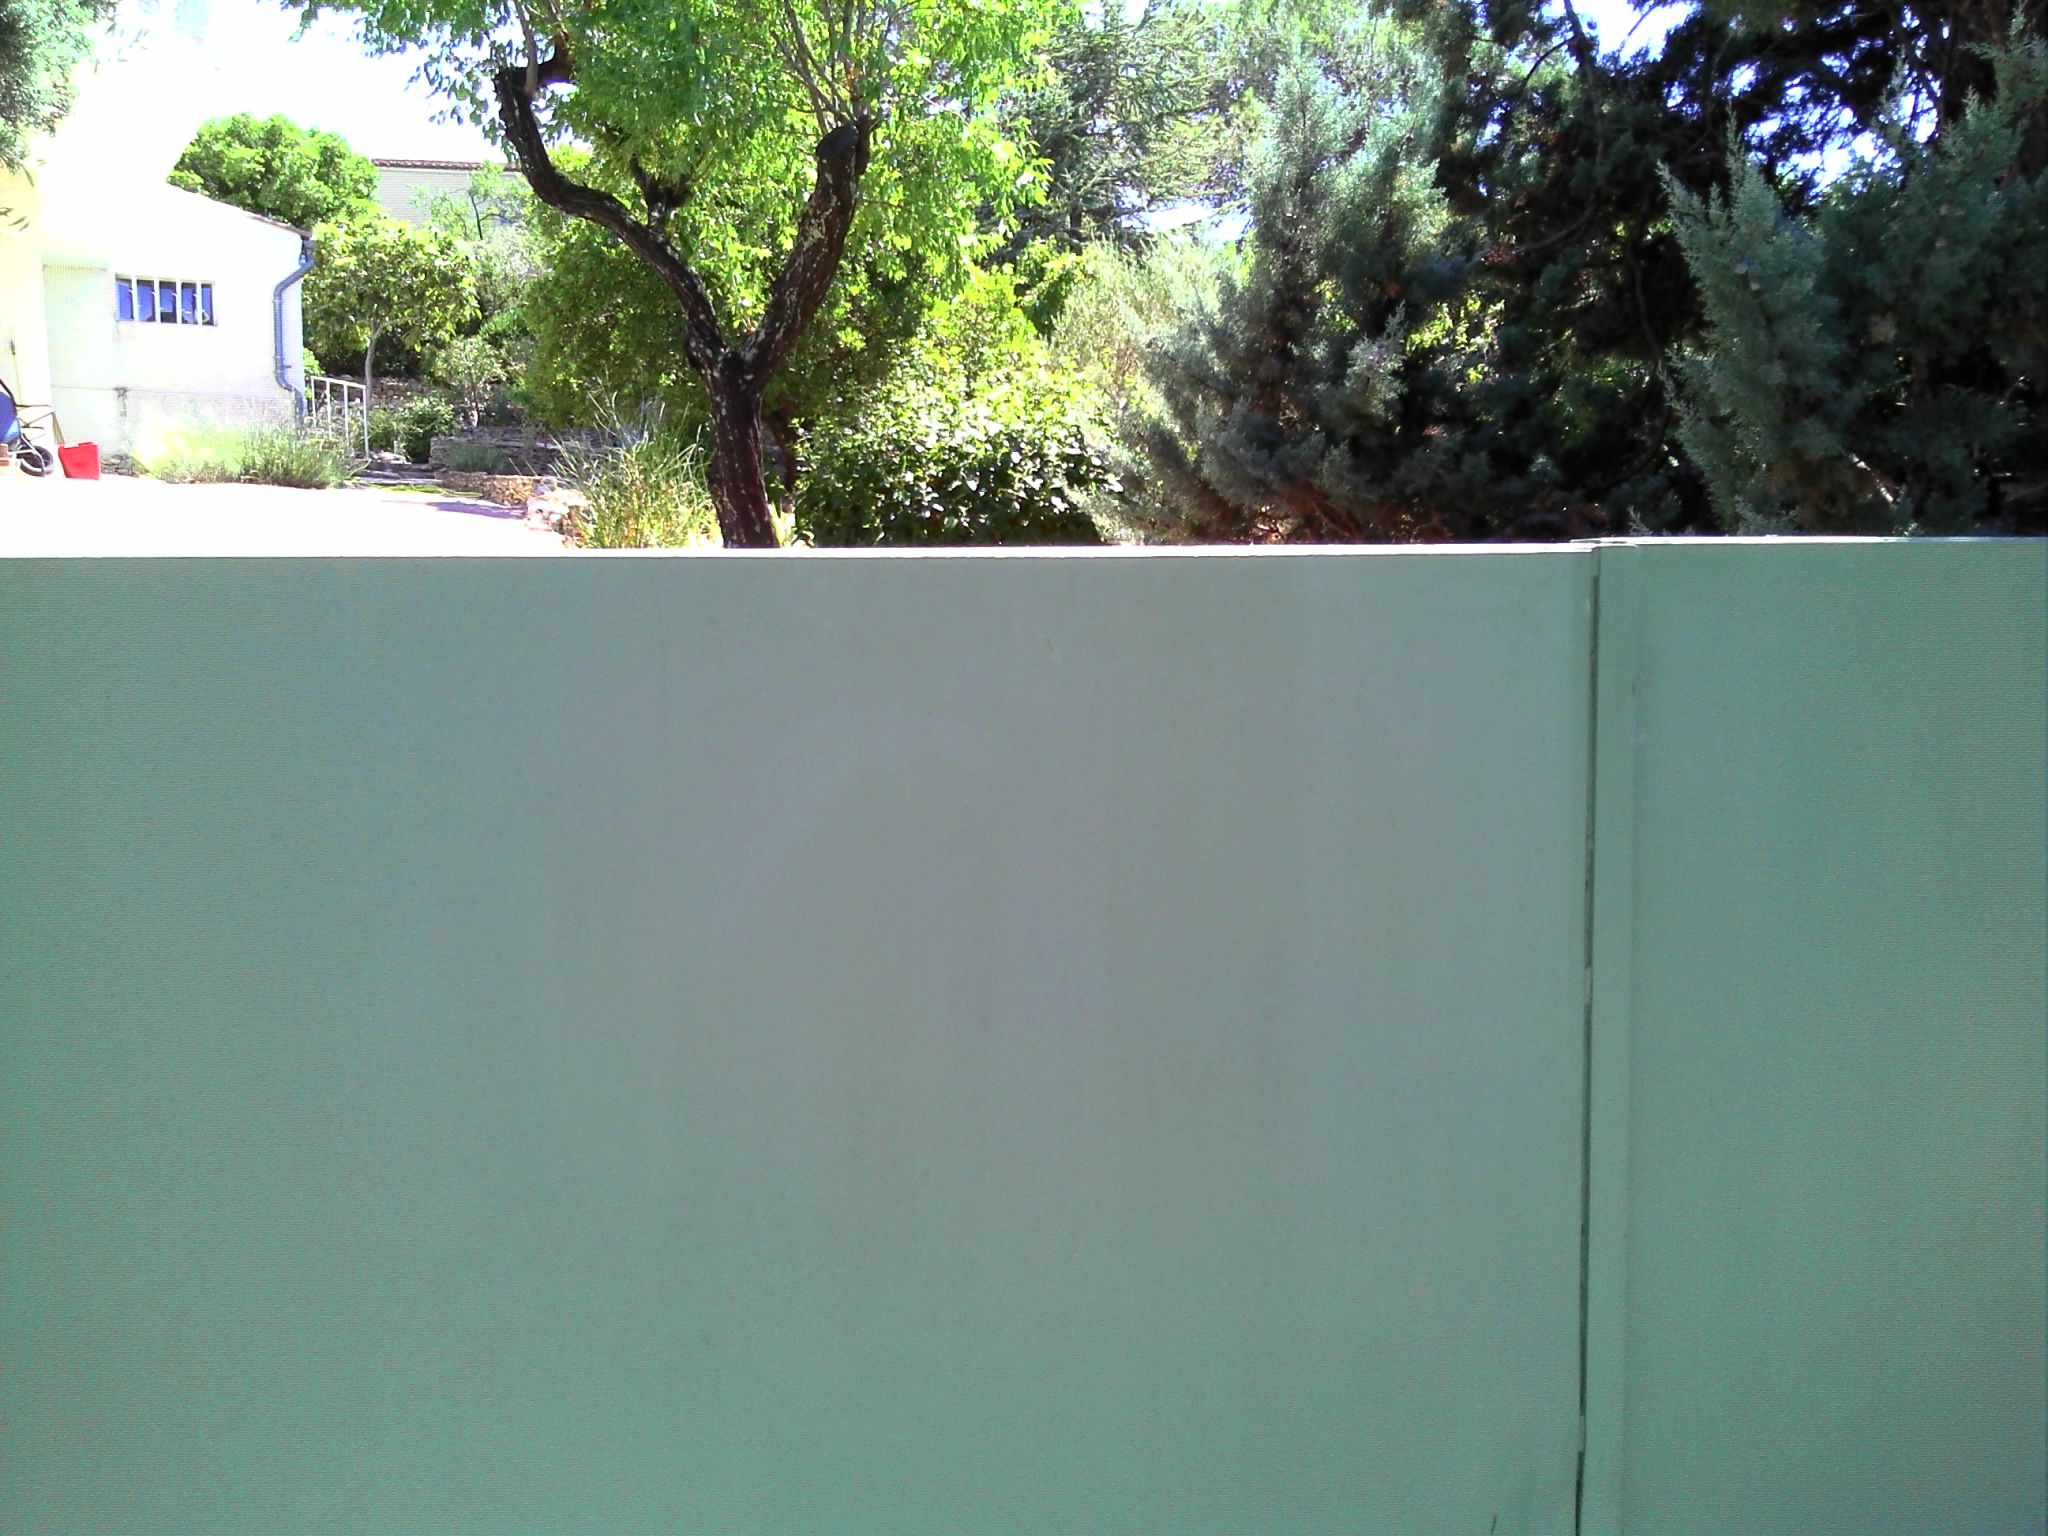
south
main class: Grassland
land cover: Grassland with sparse tree/shrub cover
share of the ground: > 75 %
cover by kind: herbaceous plants 95 %, broadleaved forest trees 5 %
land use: Residential
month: July
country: FR
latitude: 43.8517
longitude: 4.3236
